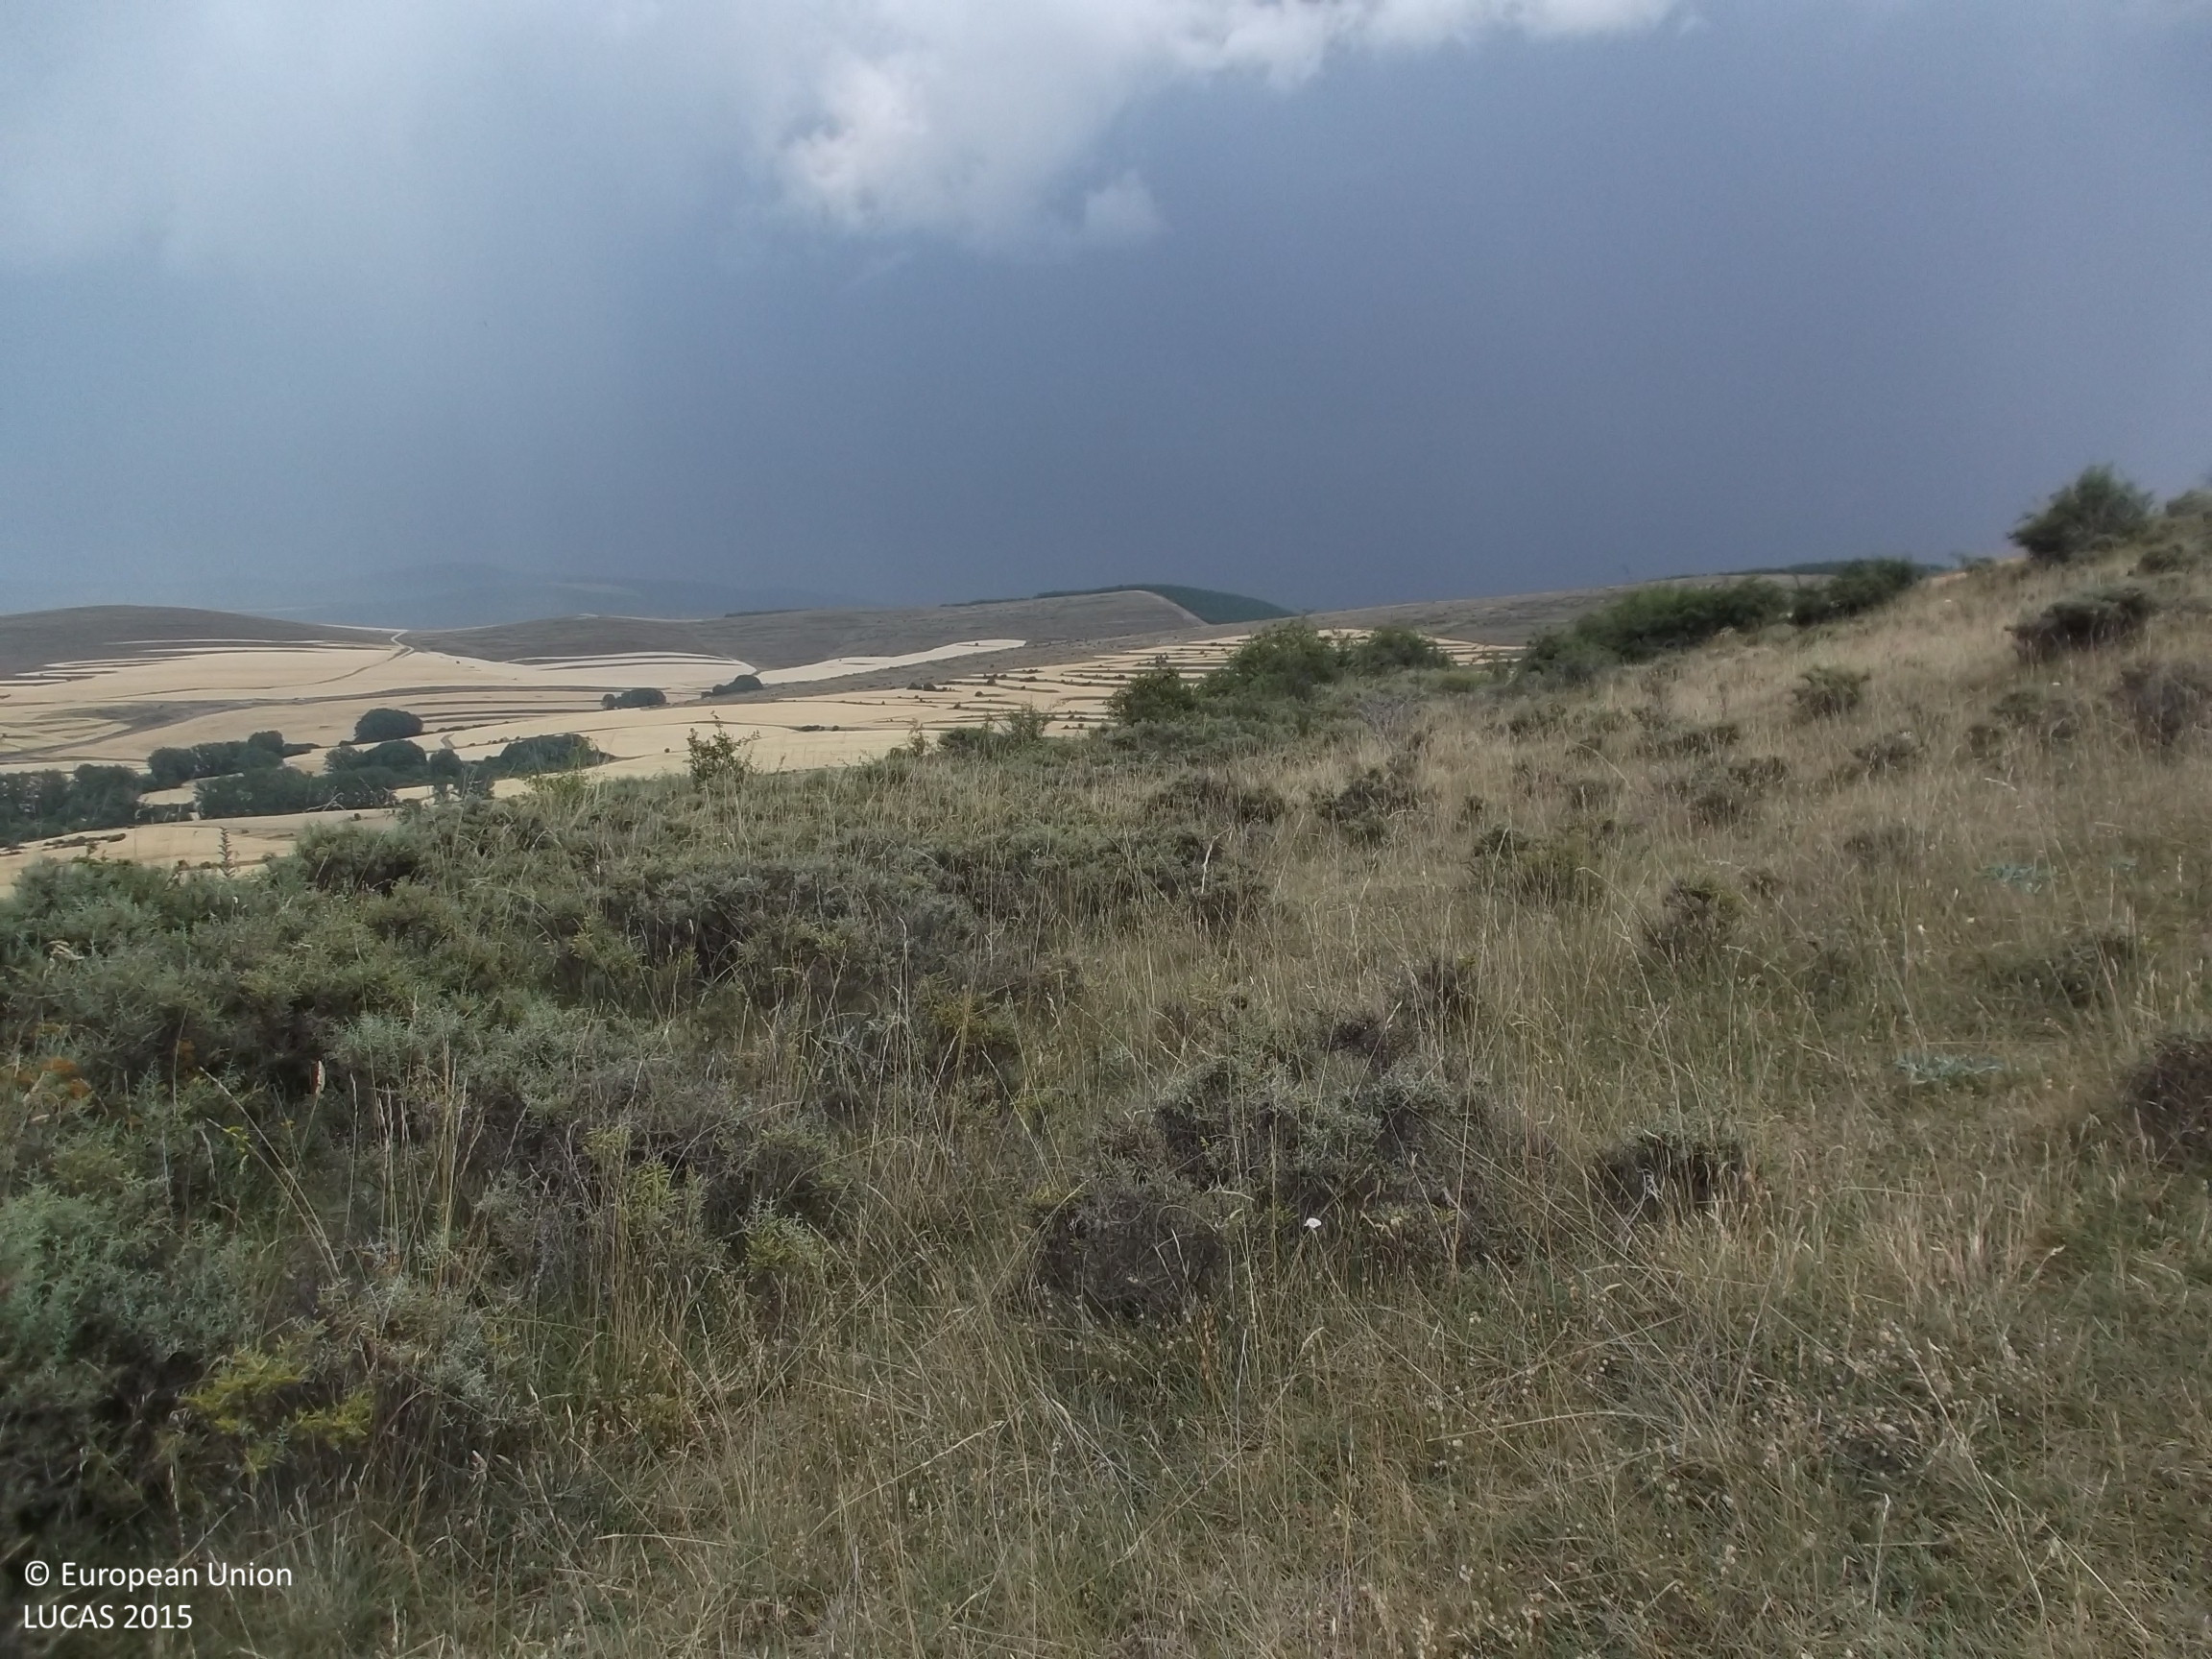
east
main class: Shrubland
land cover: Shrubland without tree cover
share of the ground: 25 - 50 %
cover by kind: shrubs 45 %, herbaceous plants 40 %, unconsolidated bare surface 10 %
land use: Abandoned areas
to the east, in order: Shrubland without tree cover; Paved roads, cycling and walking lanes; Shruby margins; Common wheat
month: July
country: ES
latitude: 41.9817
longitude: -2.2397
